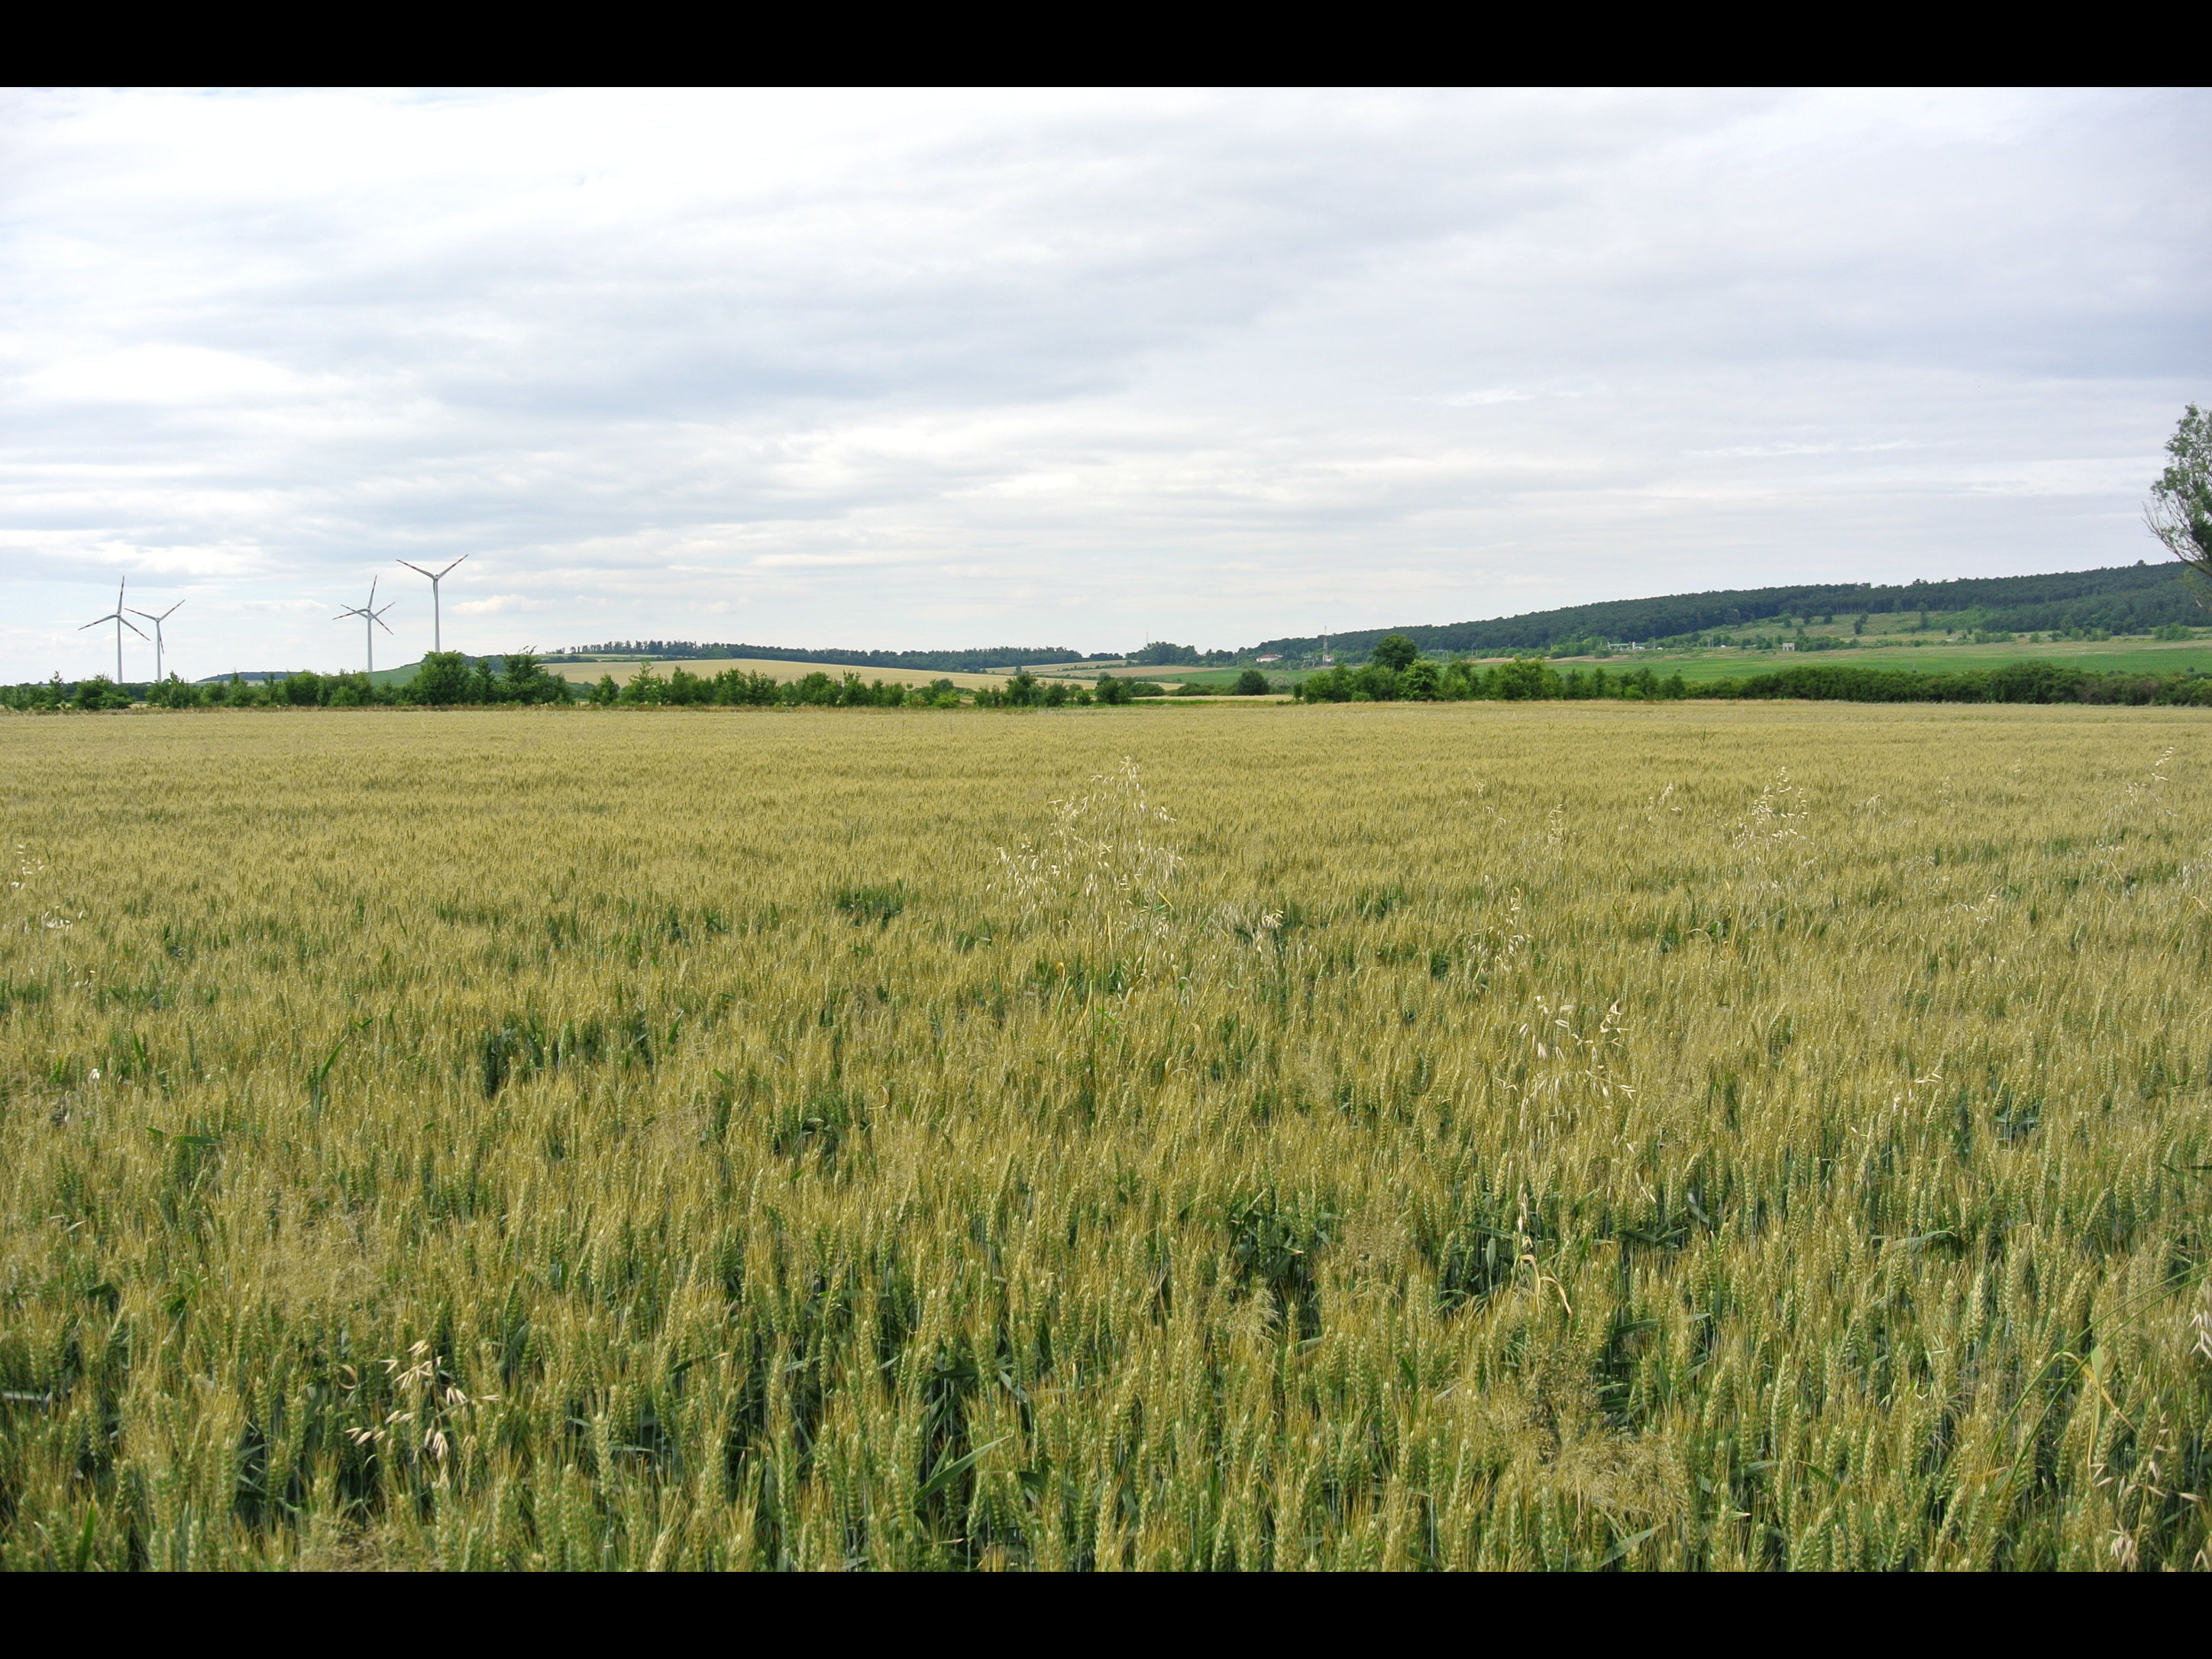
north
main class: Cropland
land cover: Common wheat
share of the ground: > 75 %
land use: Agriculture (excluding fallow land and kitchen gardens)
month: June
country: AT
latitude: 47.7218
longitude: 16.5502
